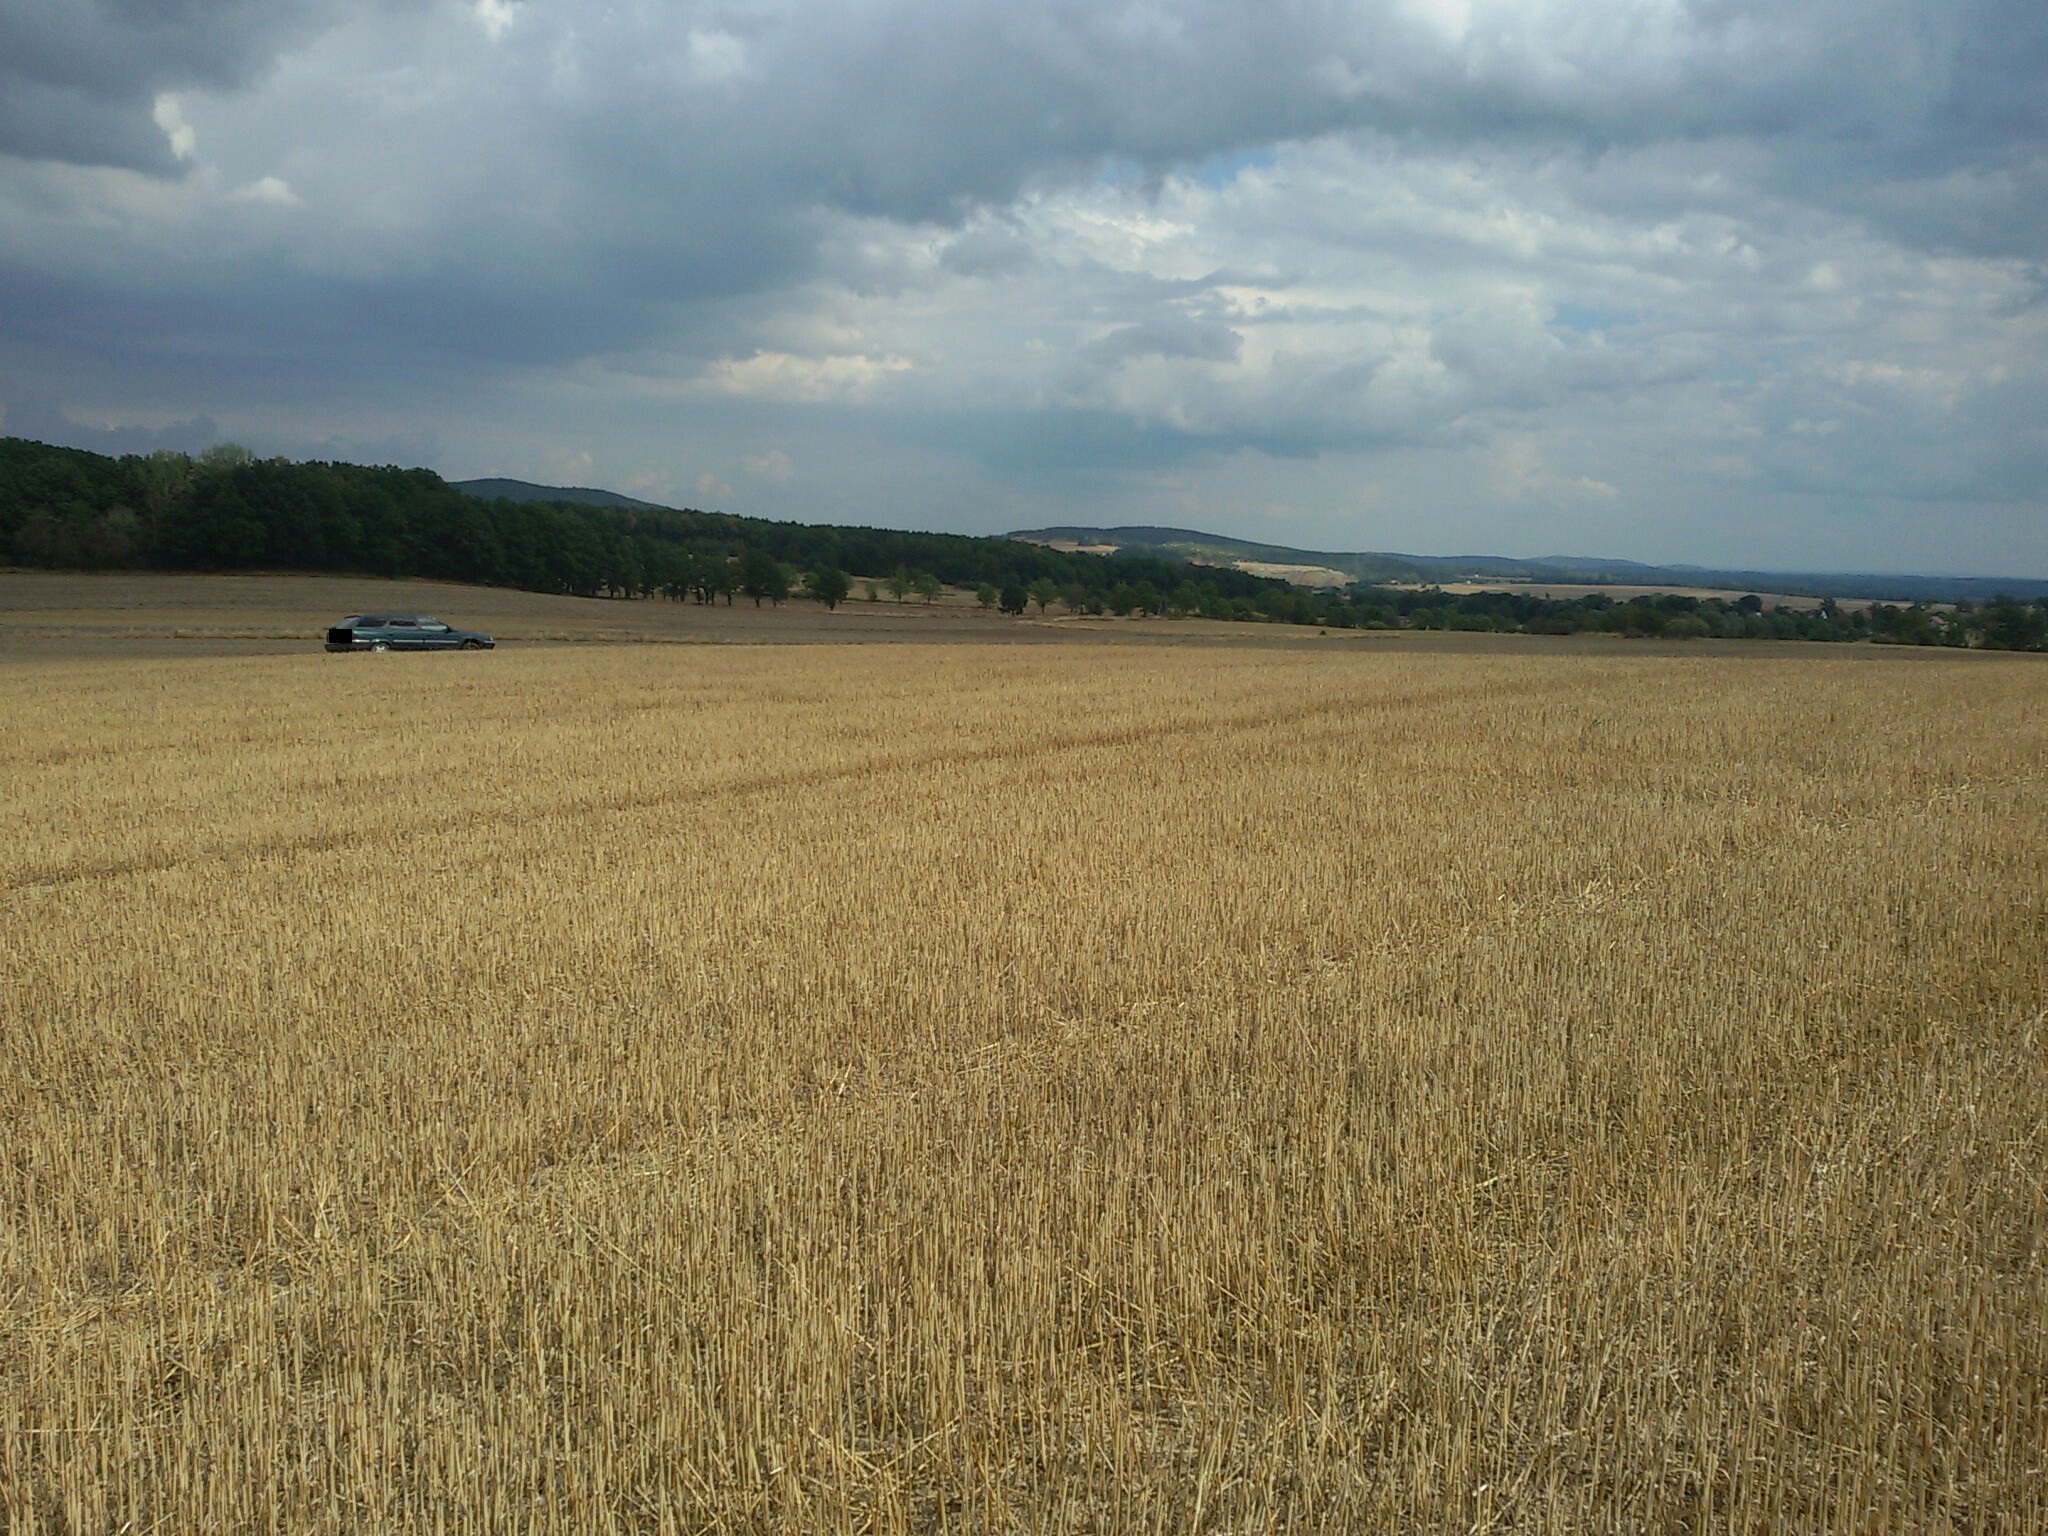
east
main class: Cropland
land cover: Common wheat
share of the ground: > 75 %
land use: Agriculture (excluding fallow land and kitchen gardens)
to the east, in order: Common wheat; Grass margins; Rape and turnip rape
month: September
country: PL
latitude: 50.5458
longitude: 16.7119
